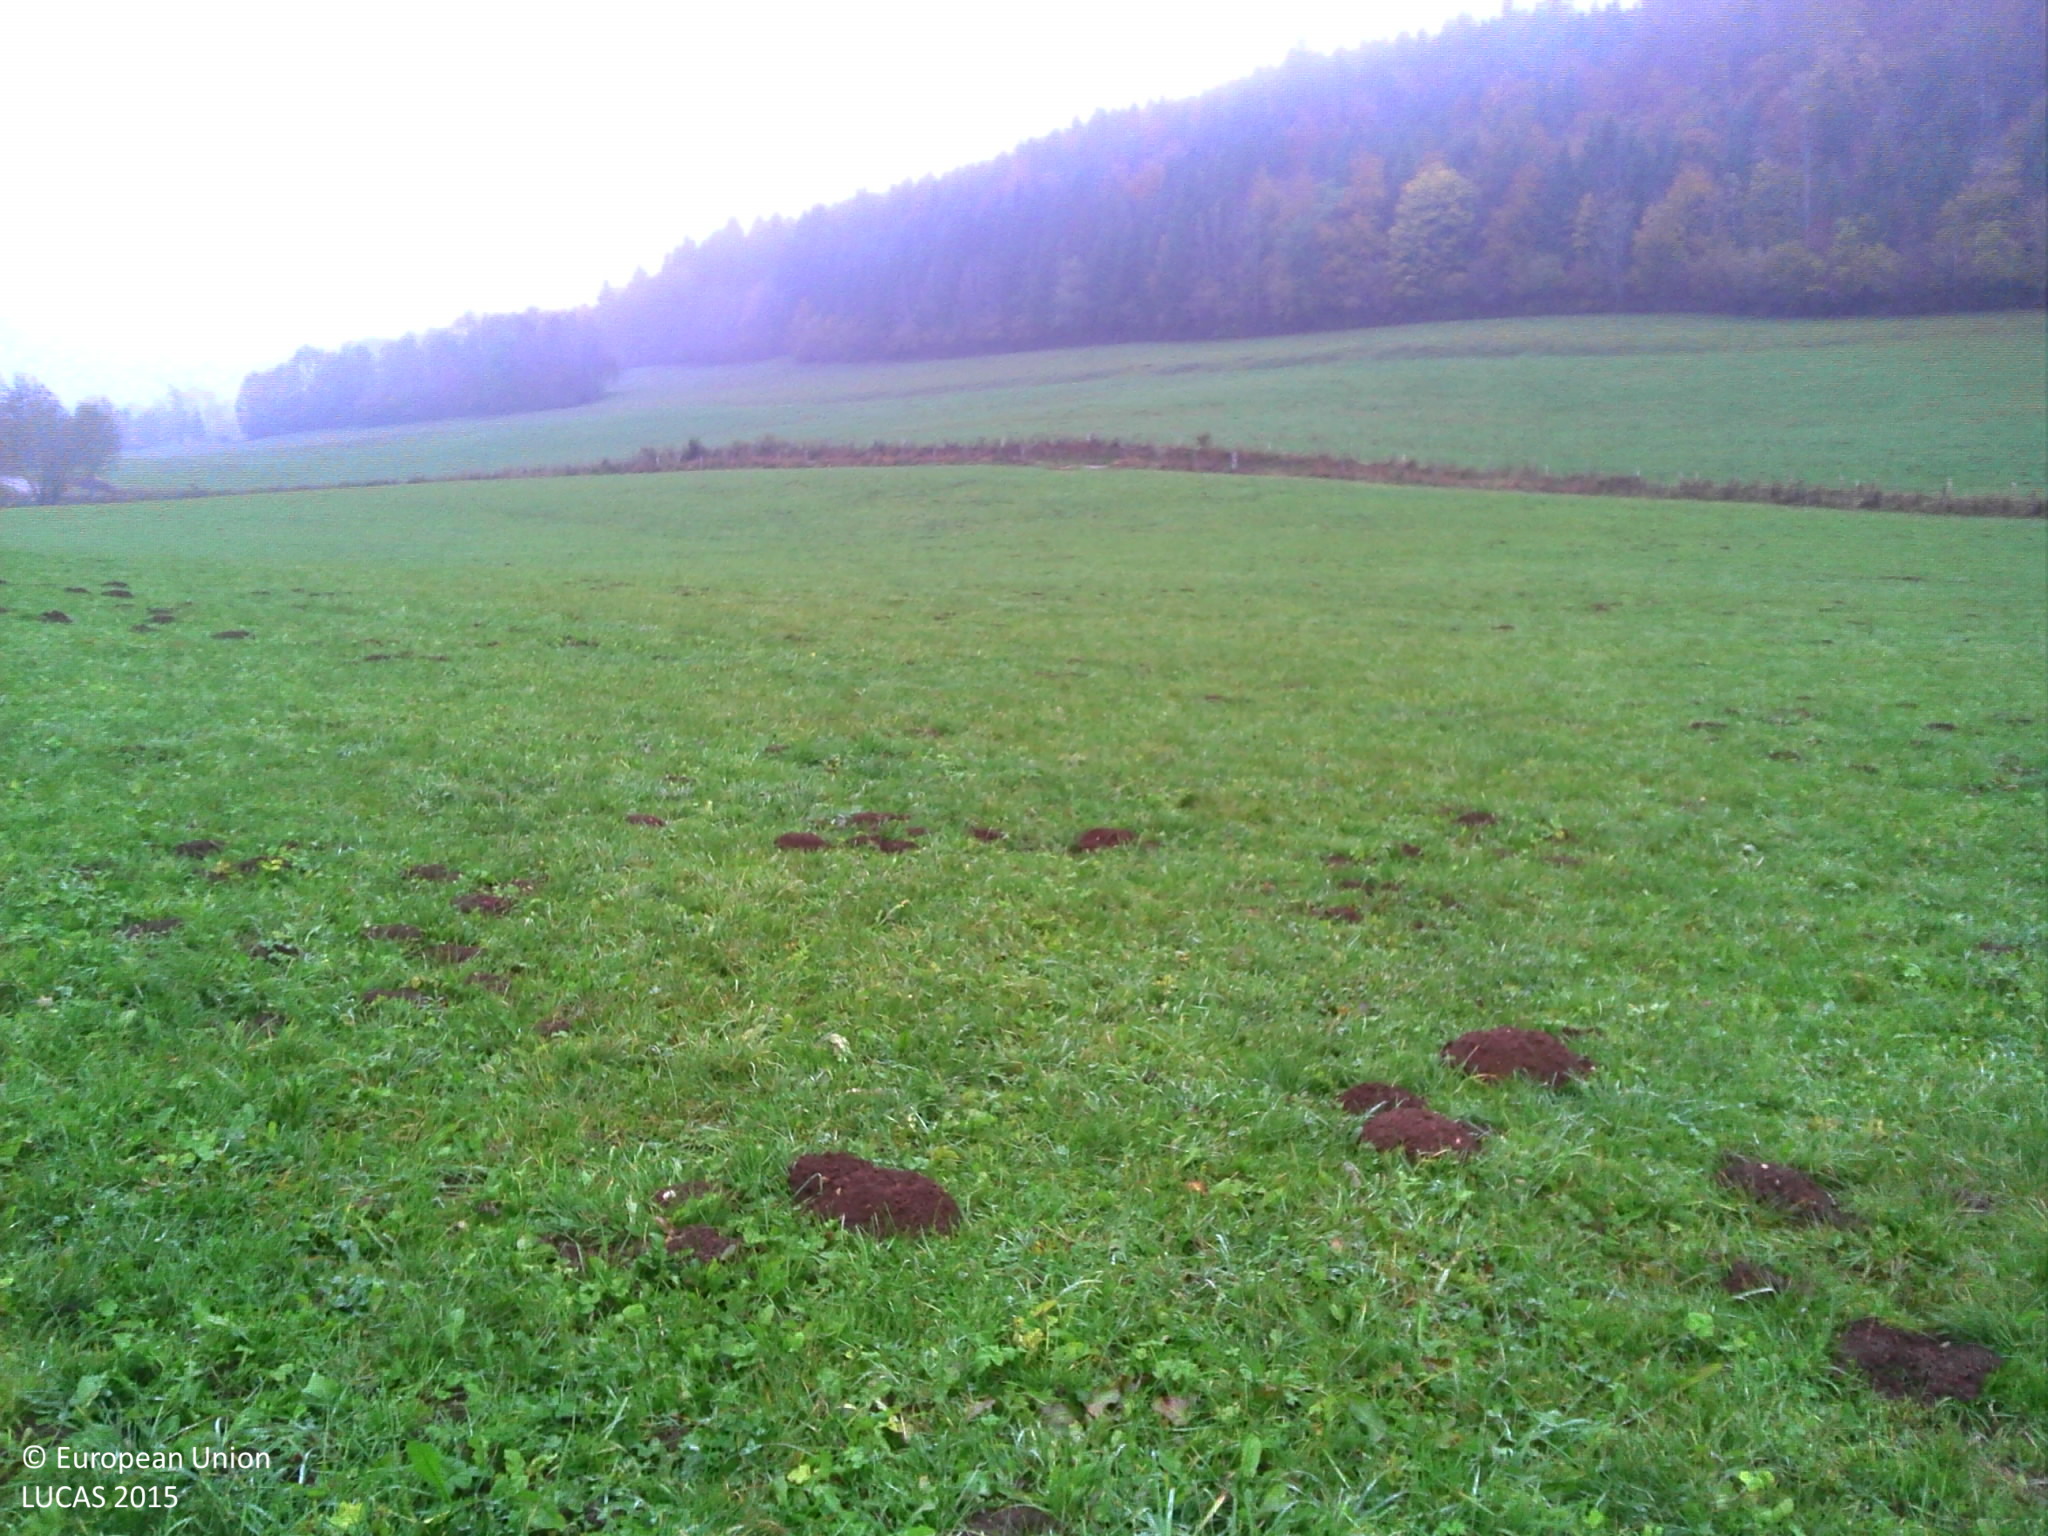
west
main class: Grassland
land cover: Grassland without tree/shrub cover
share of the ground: > 75 %
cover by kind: herbaceous plants 100 %
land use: Agriculture (excluding fallow land and kitchen gardens)
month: October
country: FR
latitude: 46.8458
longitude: 6.2913
